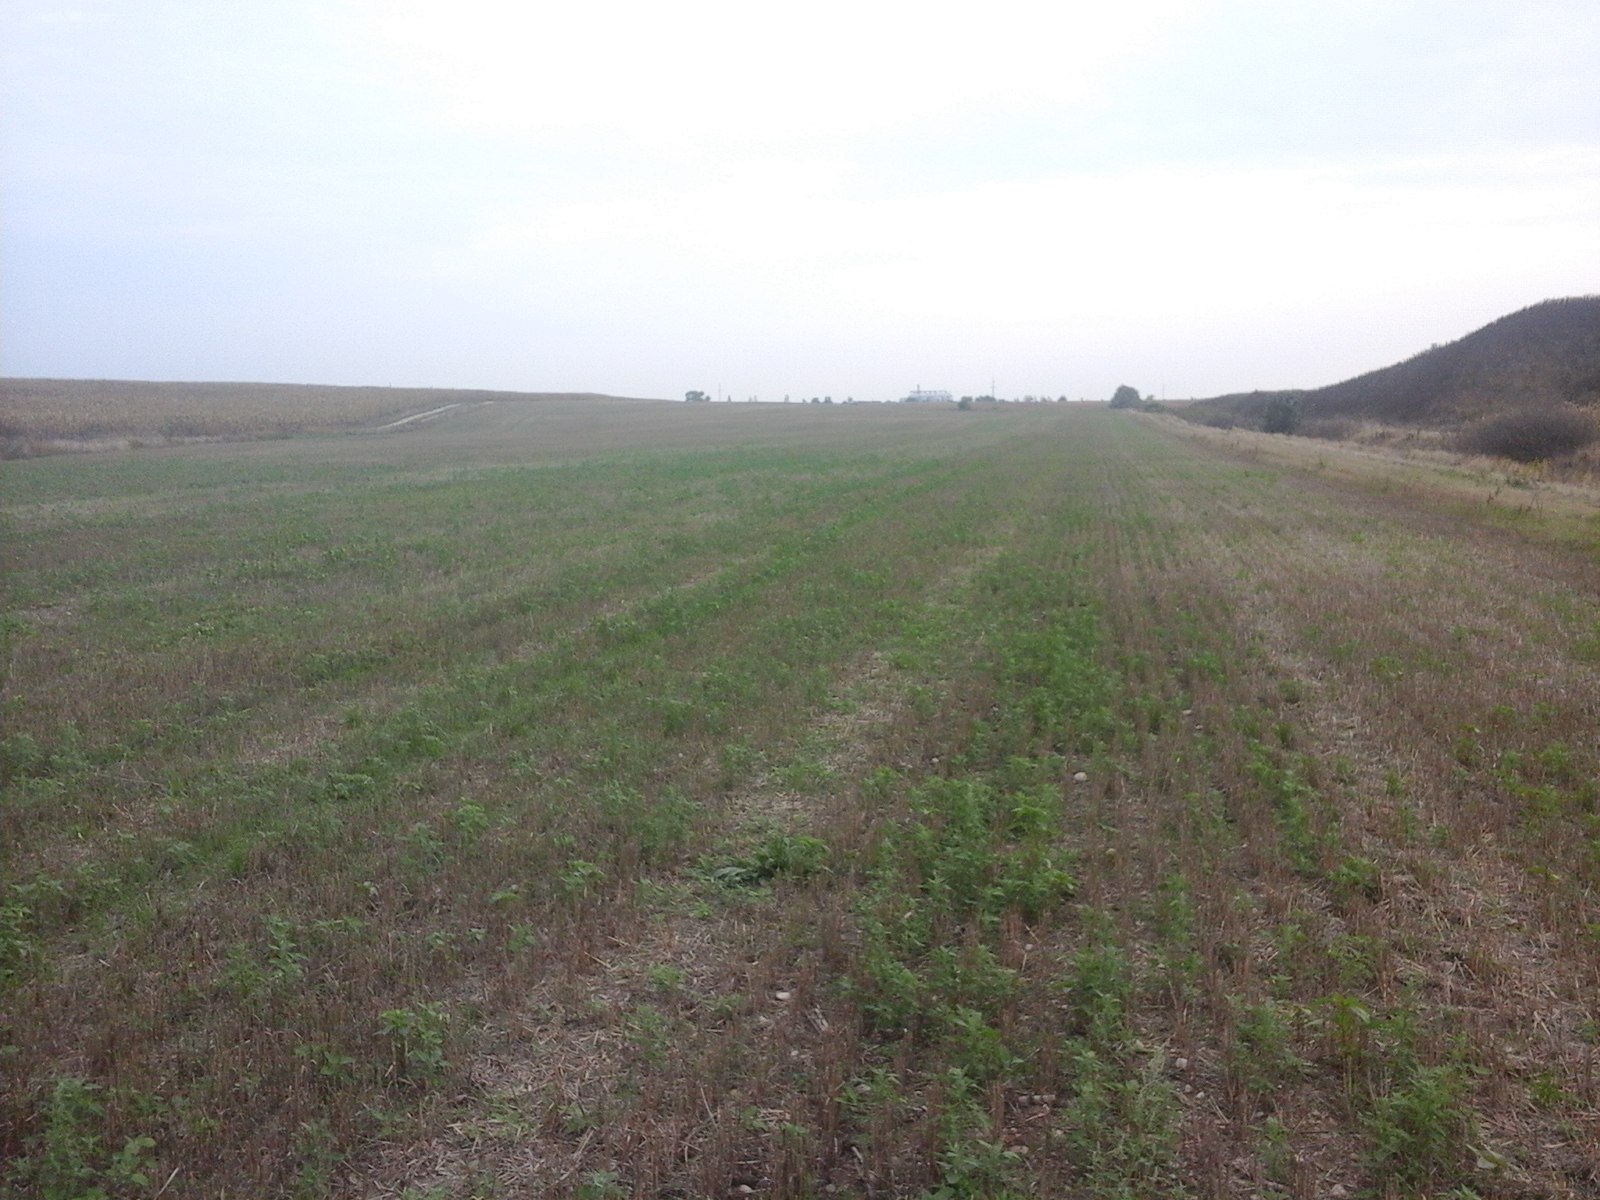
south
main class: Cropland
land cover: Common wheat
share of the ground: < 10 %
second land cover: Spontaneously vegetated surfaces
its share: 50 - 75 %
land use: Agriculture (excluding fallow land and kitchen gardens)
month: August
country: RO
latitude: 46.2365
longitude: 21.5130
